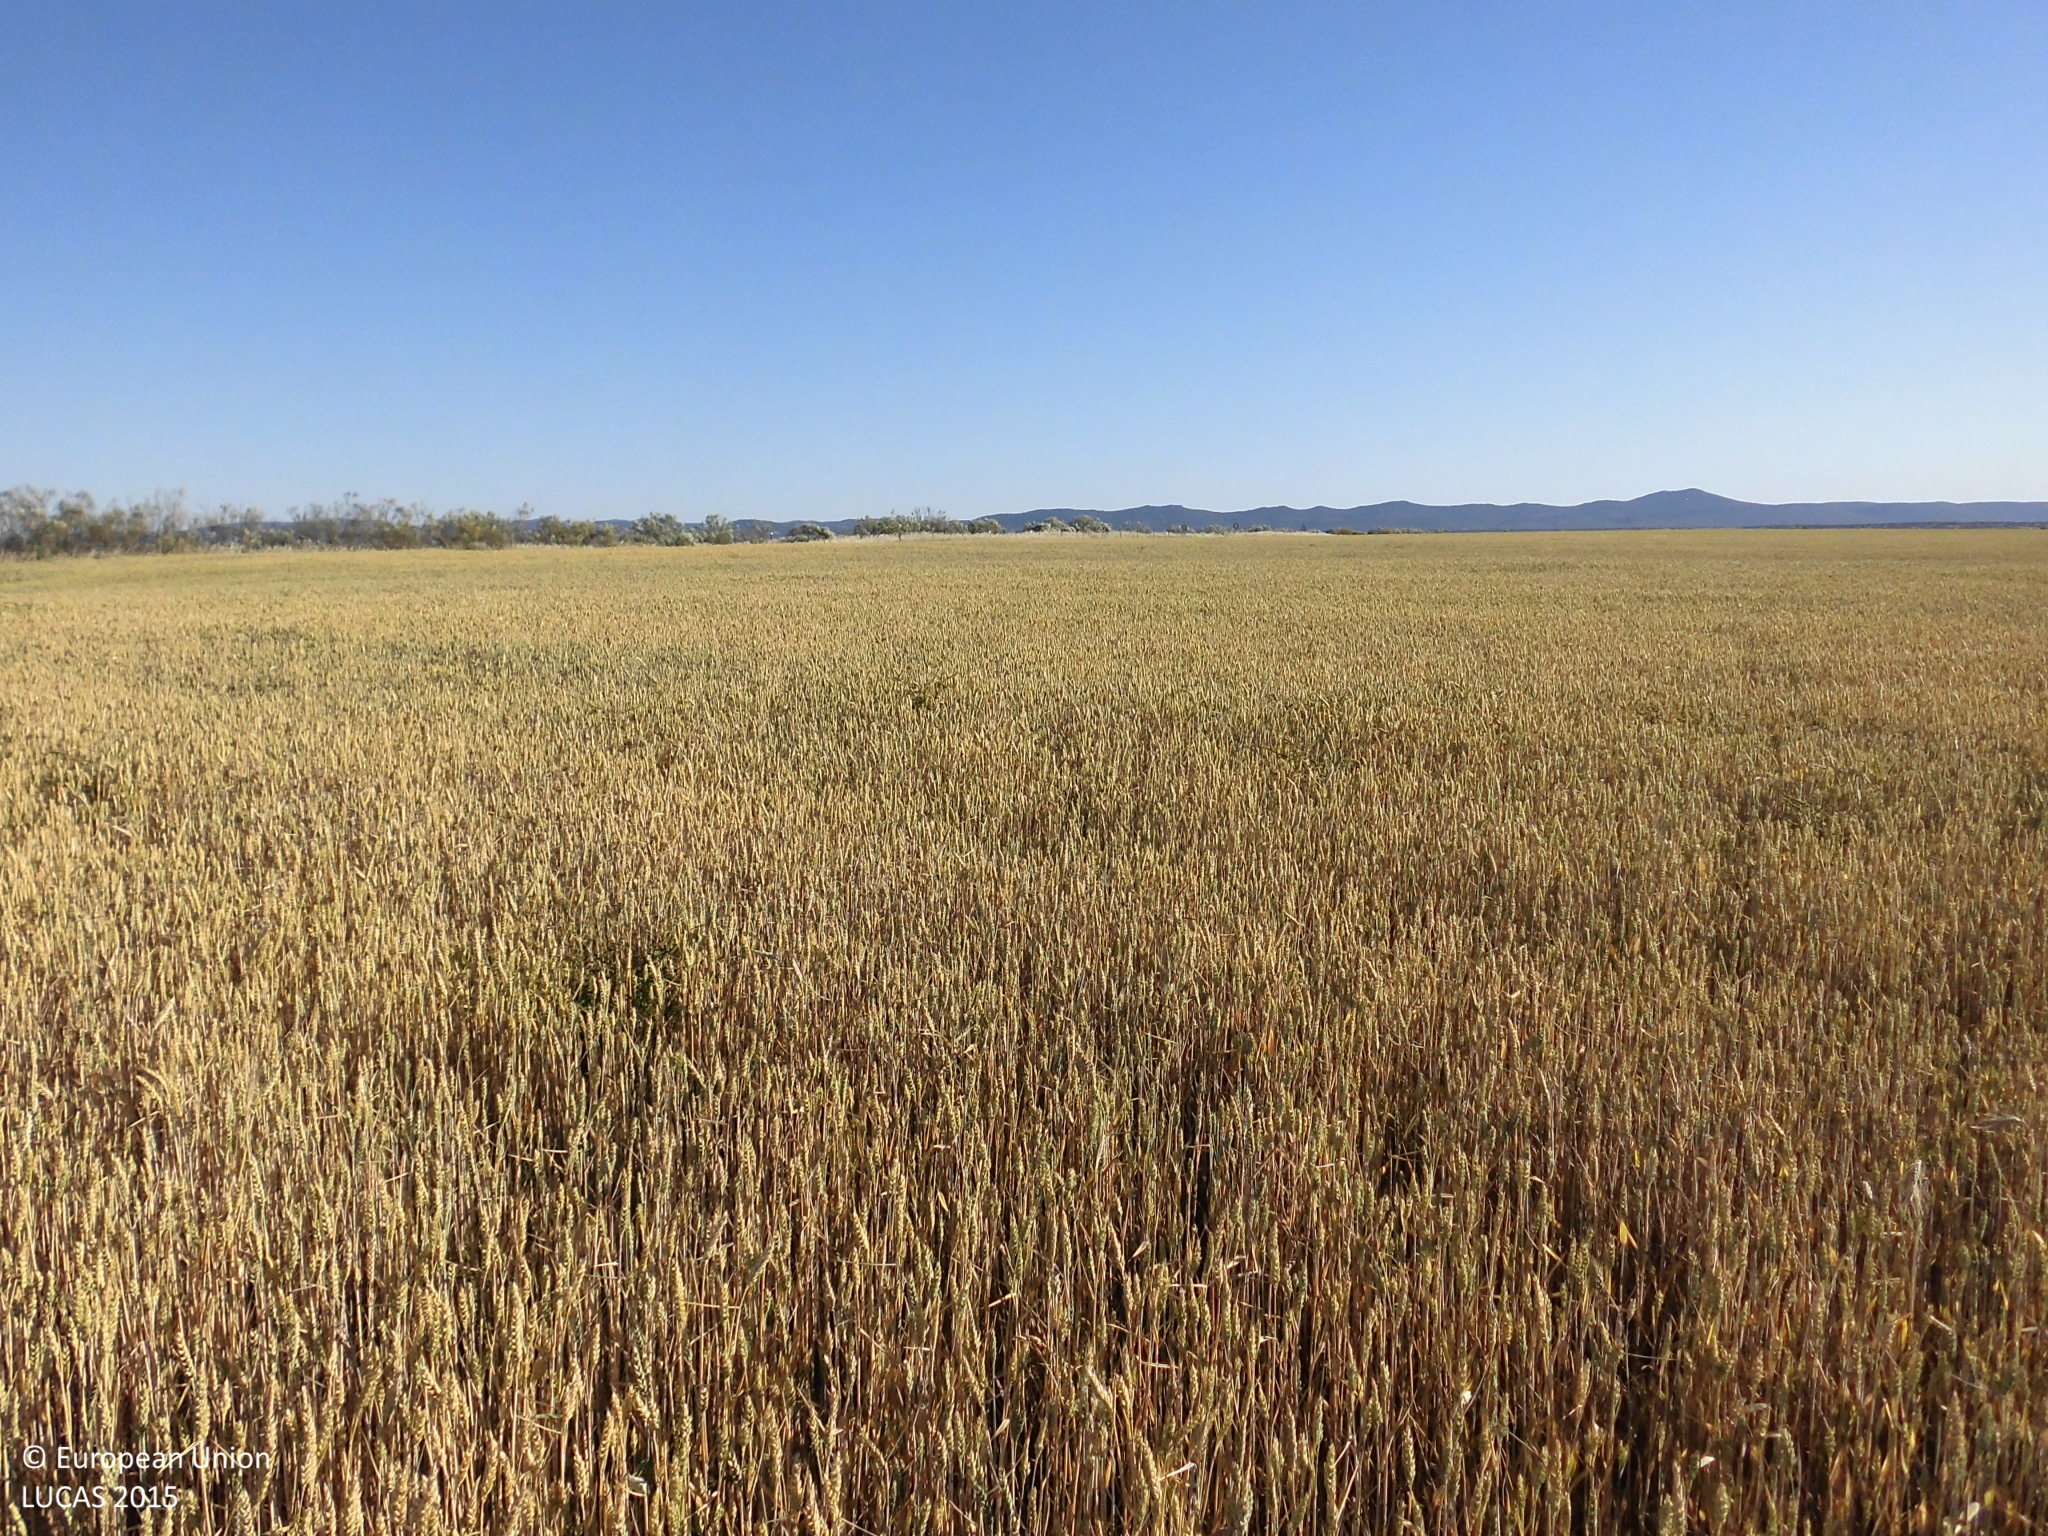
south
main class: Cropland
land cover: Common wheat
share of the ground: > 75 %
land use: Agriculture (excluding fallow land and kitchen gardens)
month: May
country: ES
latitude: 39.5148
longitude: -6.8631
